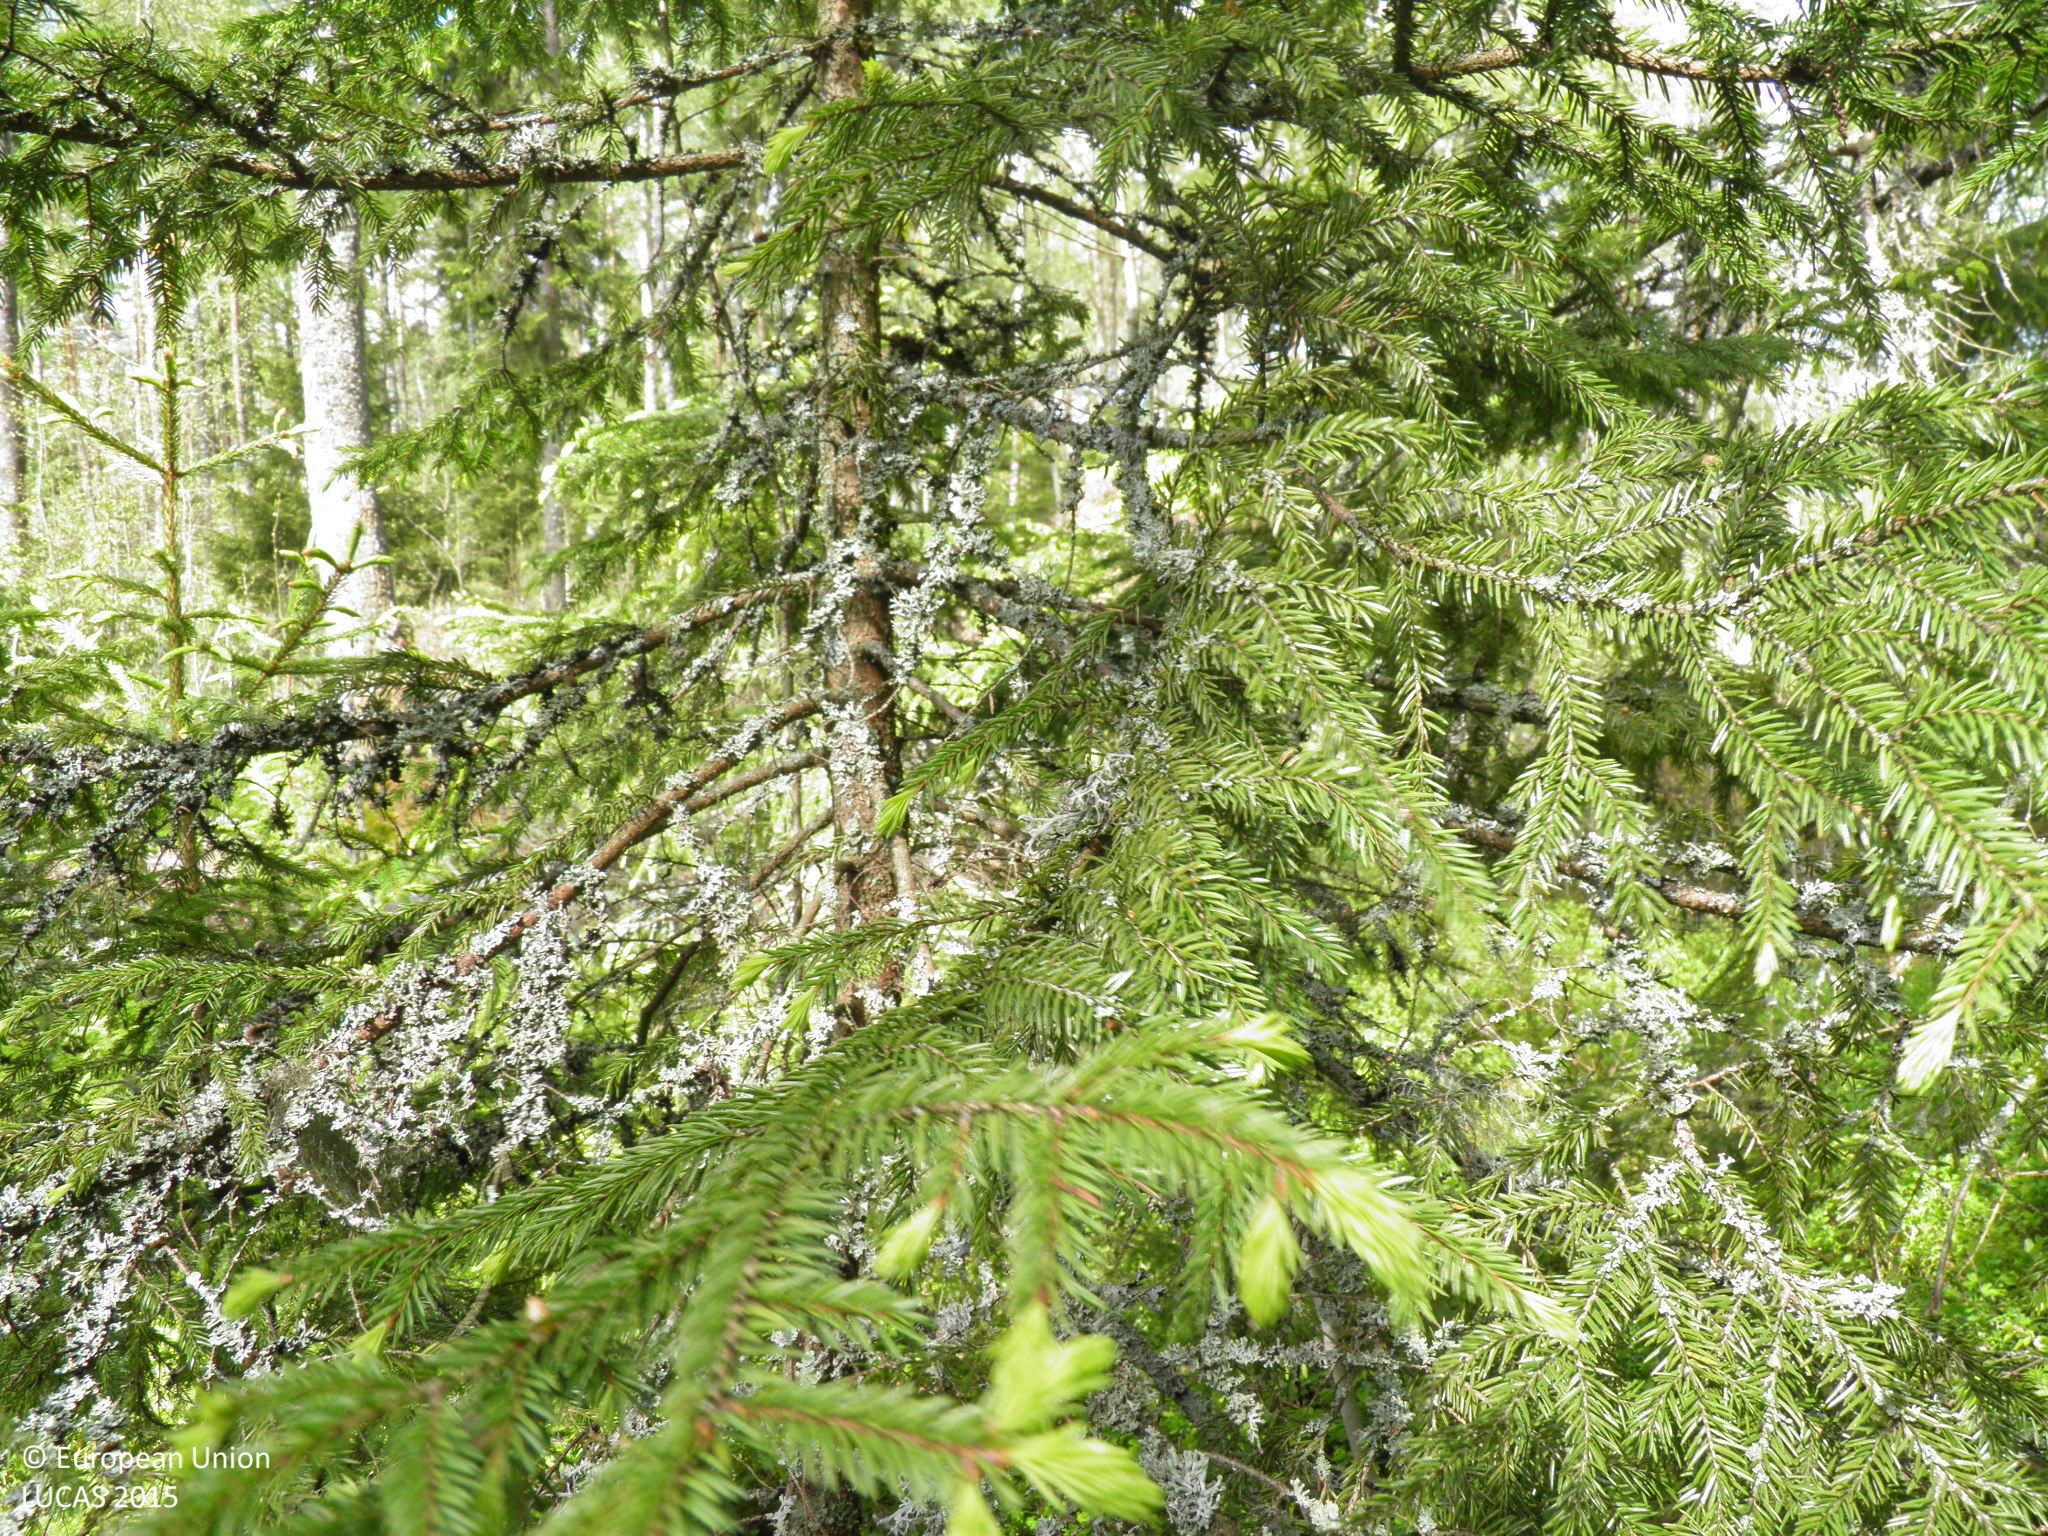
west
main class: Woodland
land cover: Spruce dominated mixed woodland
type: boreal forest
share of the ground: > 75 %
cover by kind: coniferous forest trees 65 %, broadleaved forest trees 25 %, shrubs 10 %
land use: Forestry
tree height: > 5 m
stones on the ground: < 10 %
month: May
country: FI
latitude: 60.3724
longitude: 22.2721
